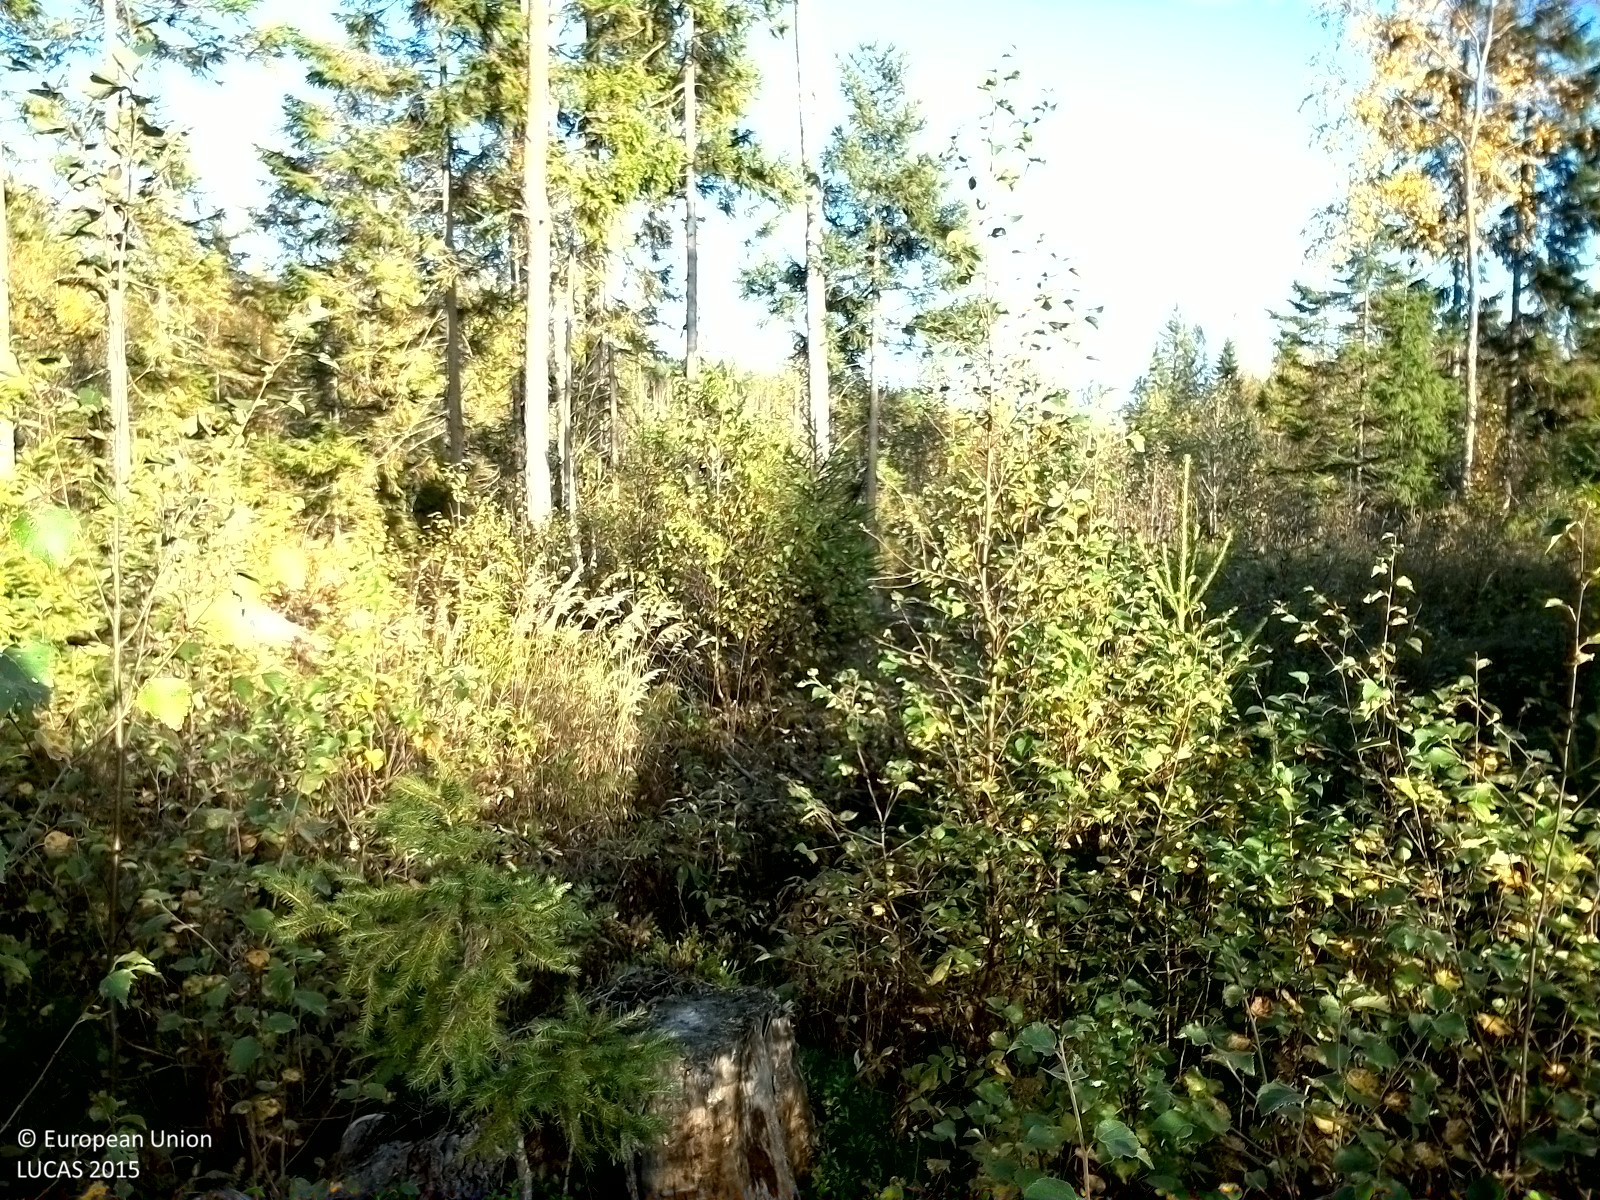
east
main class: Woodland
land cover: Spruce dominated mixed woodland
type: boreal forest
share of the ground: > 75 %
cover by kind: broadleaved forest trees 60 %, coniferous forest trees 20 %, shrubs 20 %
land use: Forestry
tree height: < 5 m
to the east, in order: Spruce dominated mixed woodland; Other mixed woodland; Ditches and canals; Other mixed woodland; Ditches and canals; Tracks; Broadleaved woodland; Ditches and canals; Other mixed woodland; Other bare soil; Other mixed woodland
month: September
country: SE
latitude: 62.0958
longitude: 16.8194
